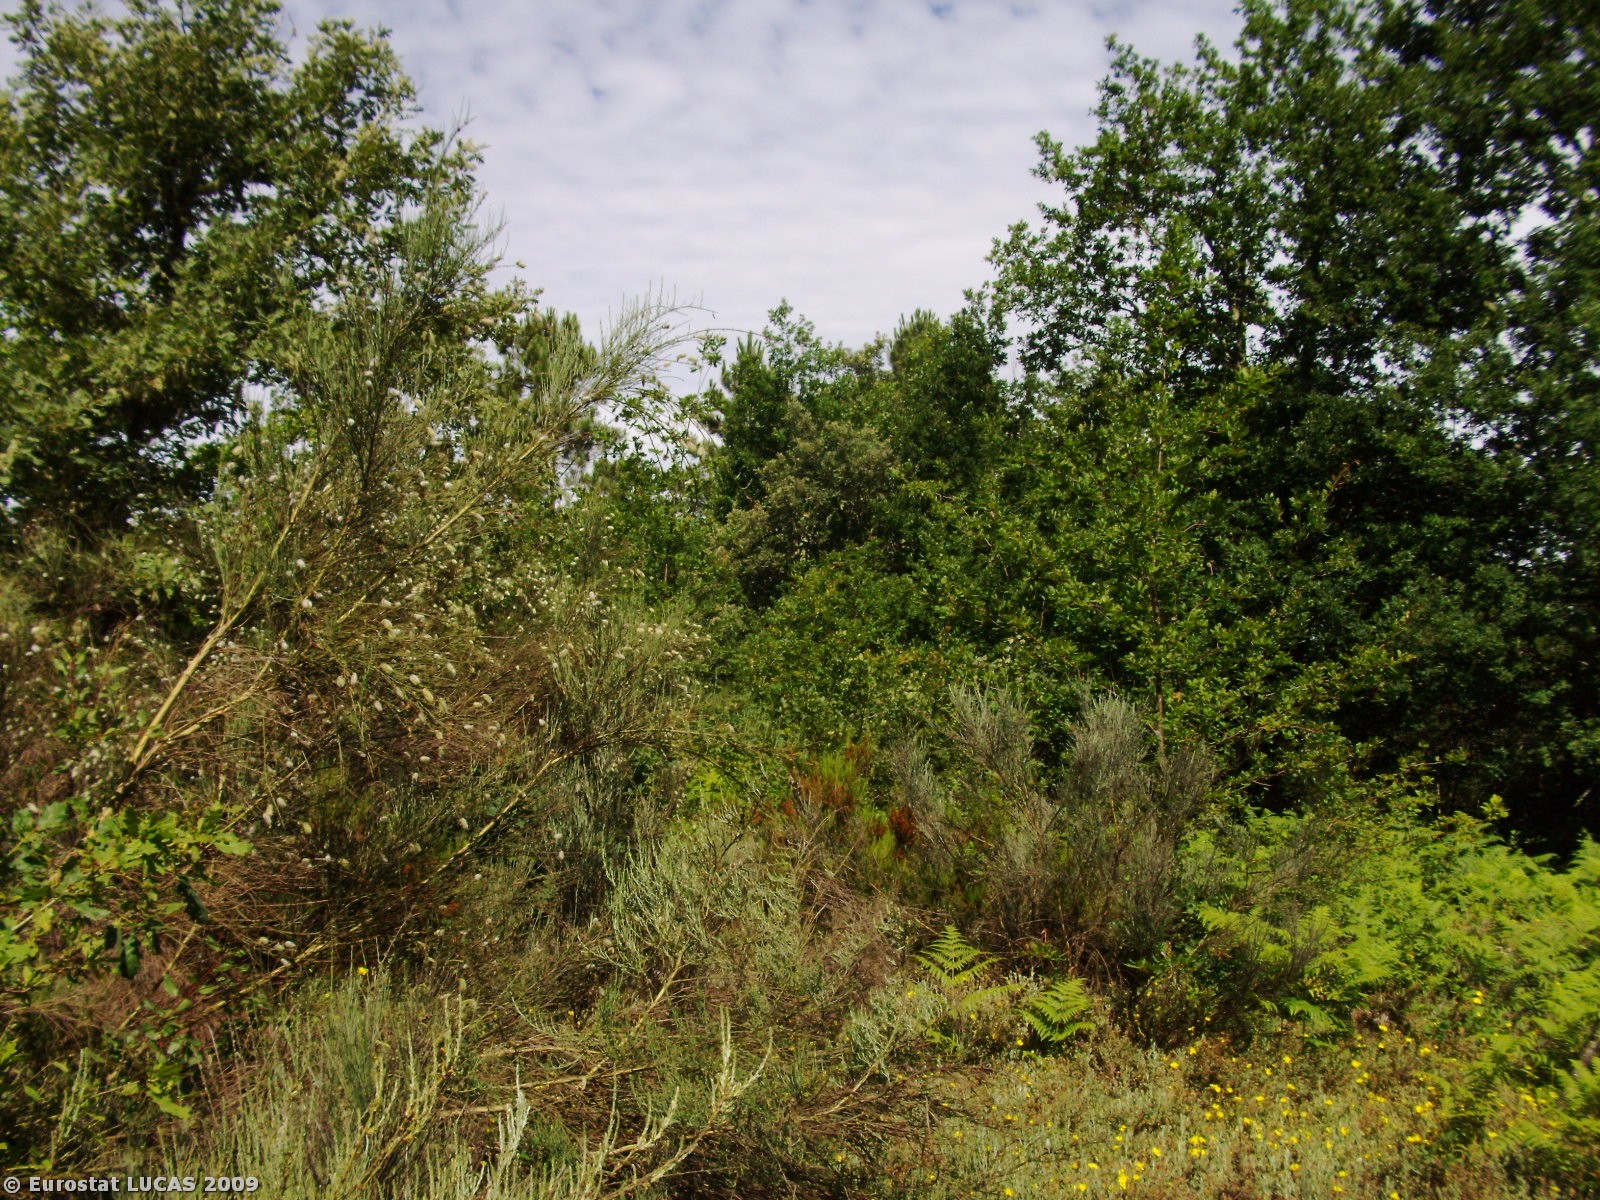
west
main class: Woodland
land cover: Broadleaved woodland
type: mesophytic deciduous forest
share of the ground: > 75 %
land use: Forestry
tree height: > 5 m
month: July
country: PT
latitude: 40.8430
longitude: -7.6868
